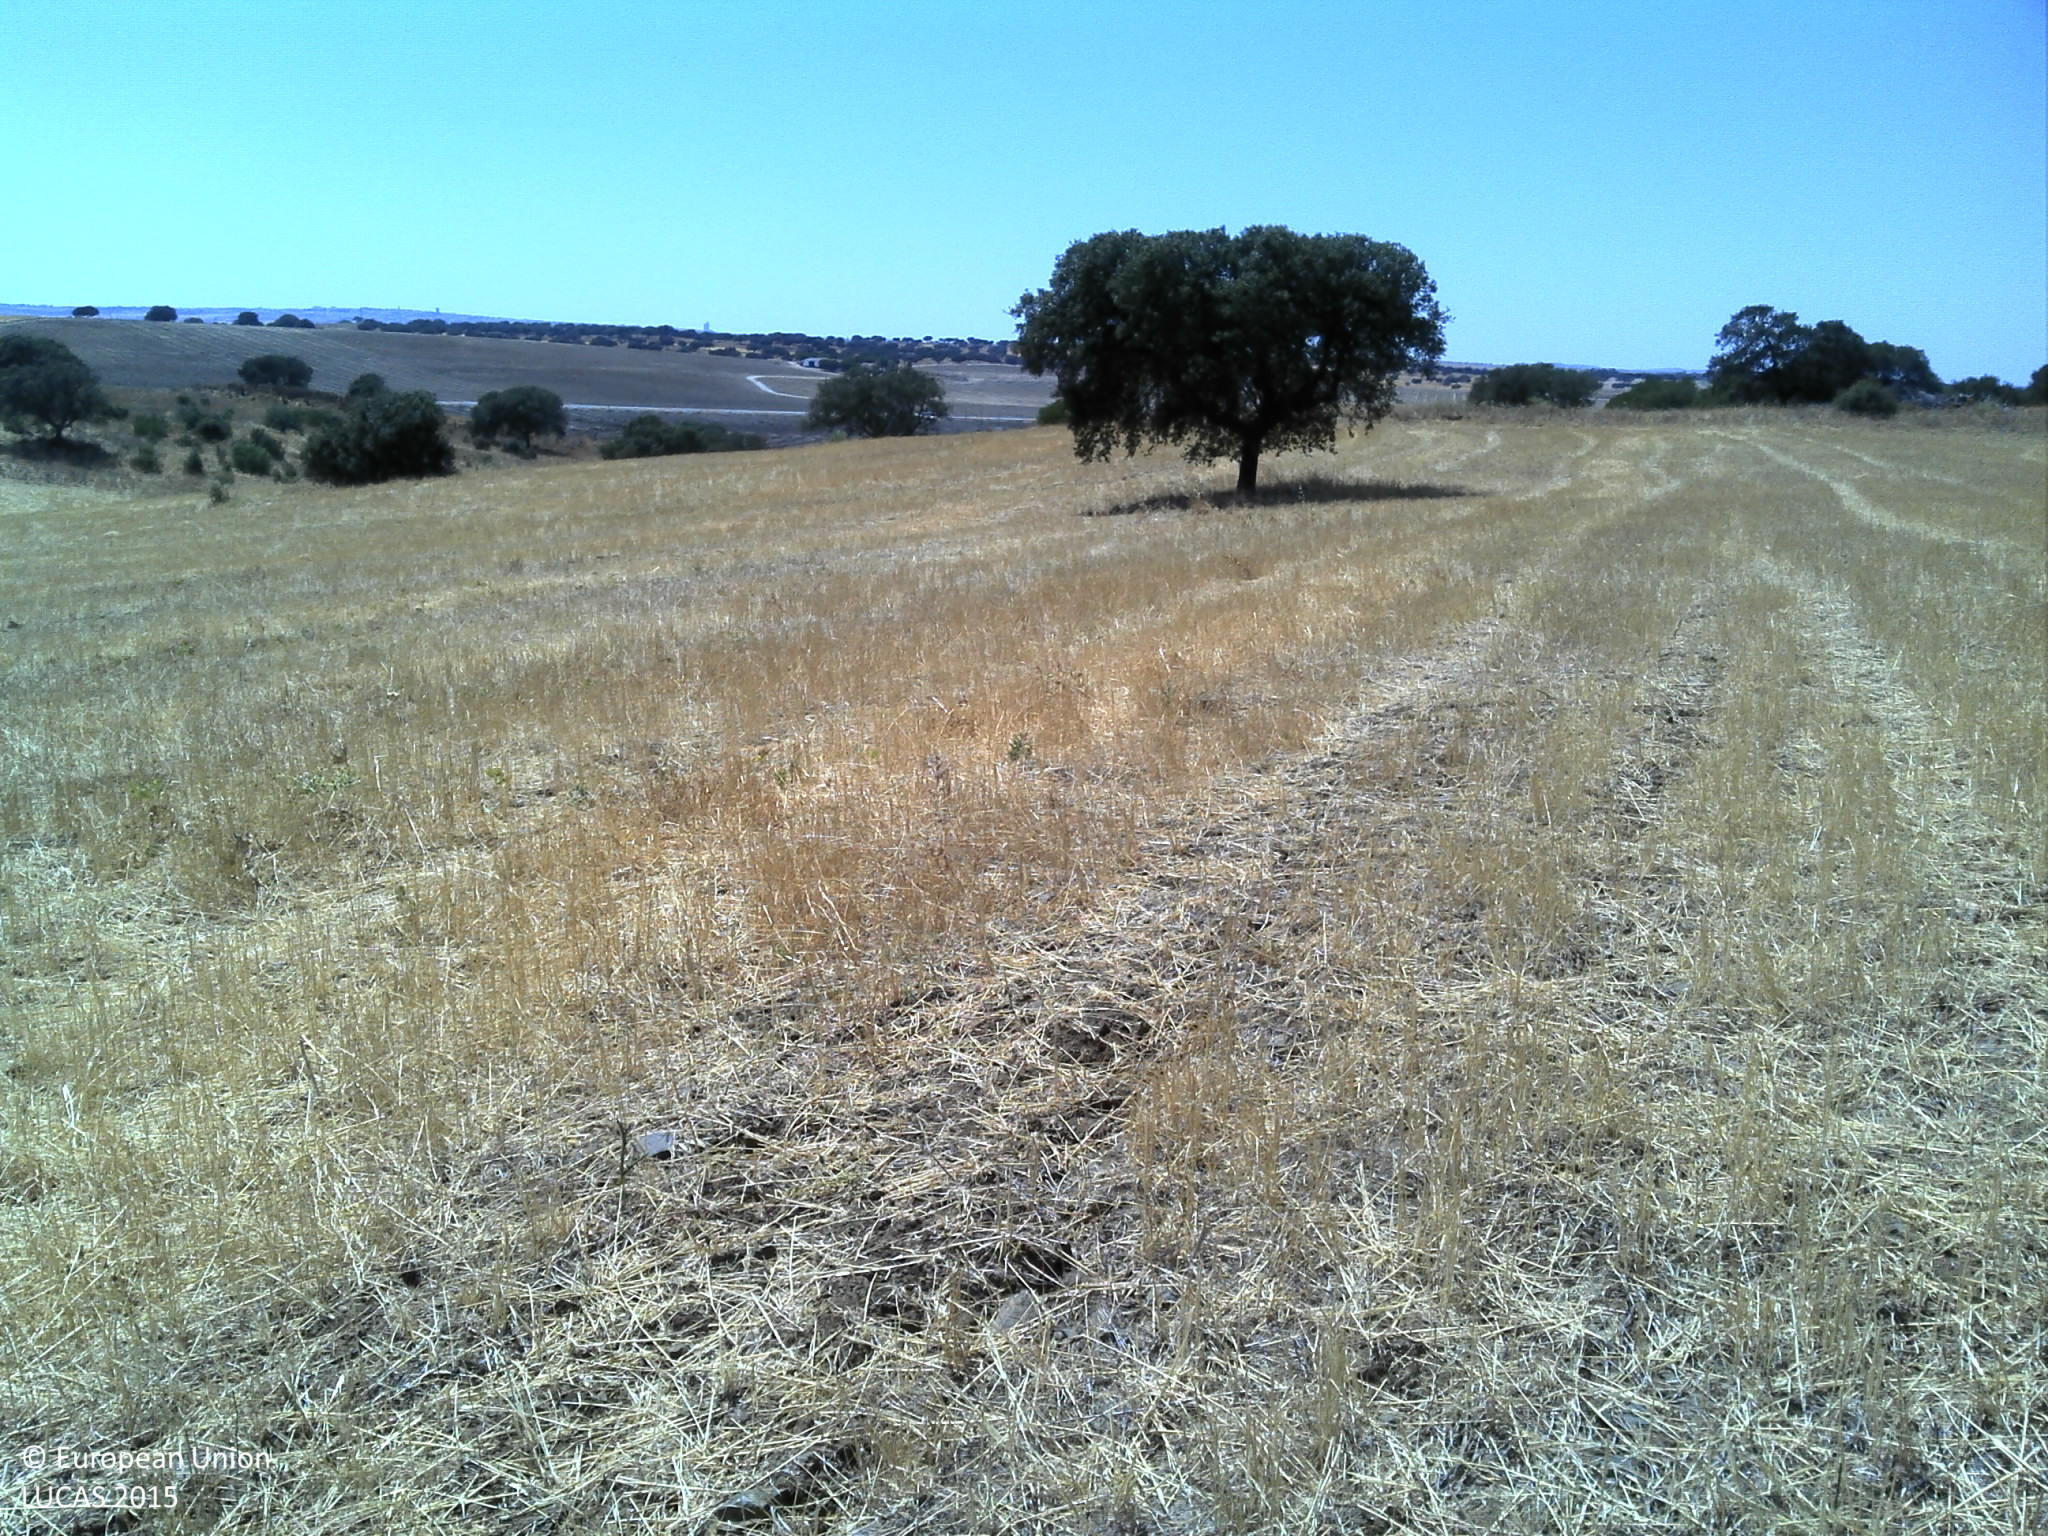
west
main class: Cropland
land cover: Common wheat
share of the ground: > 75 %
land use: Agriculture (excluding fallow land and kitchen gardens)
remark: Harvested field
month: August
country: PT
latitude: 38.0480
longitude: -7.7221
